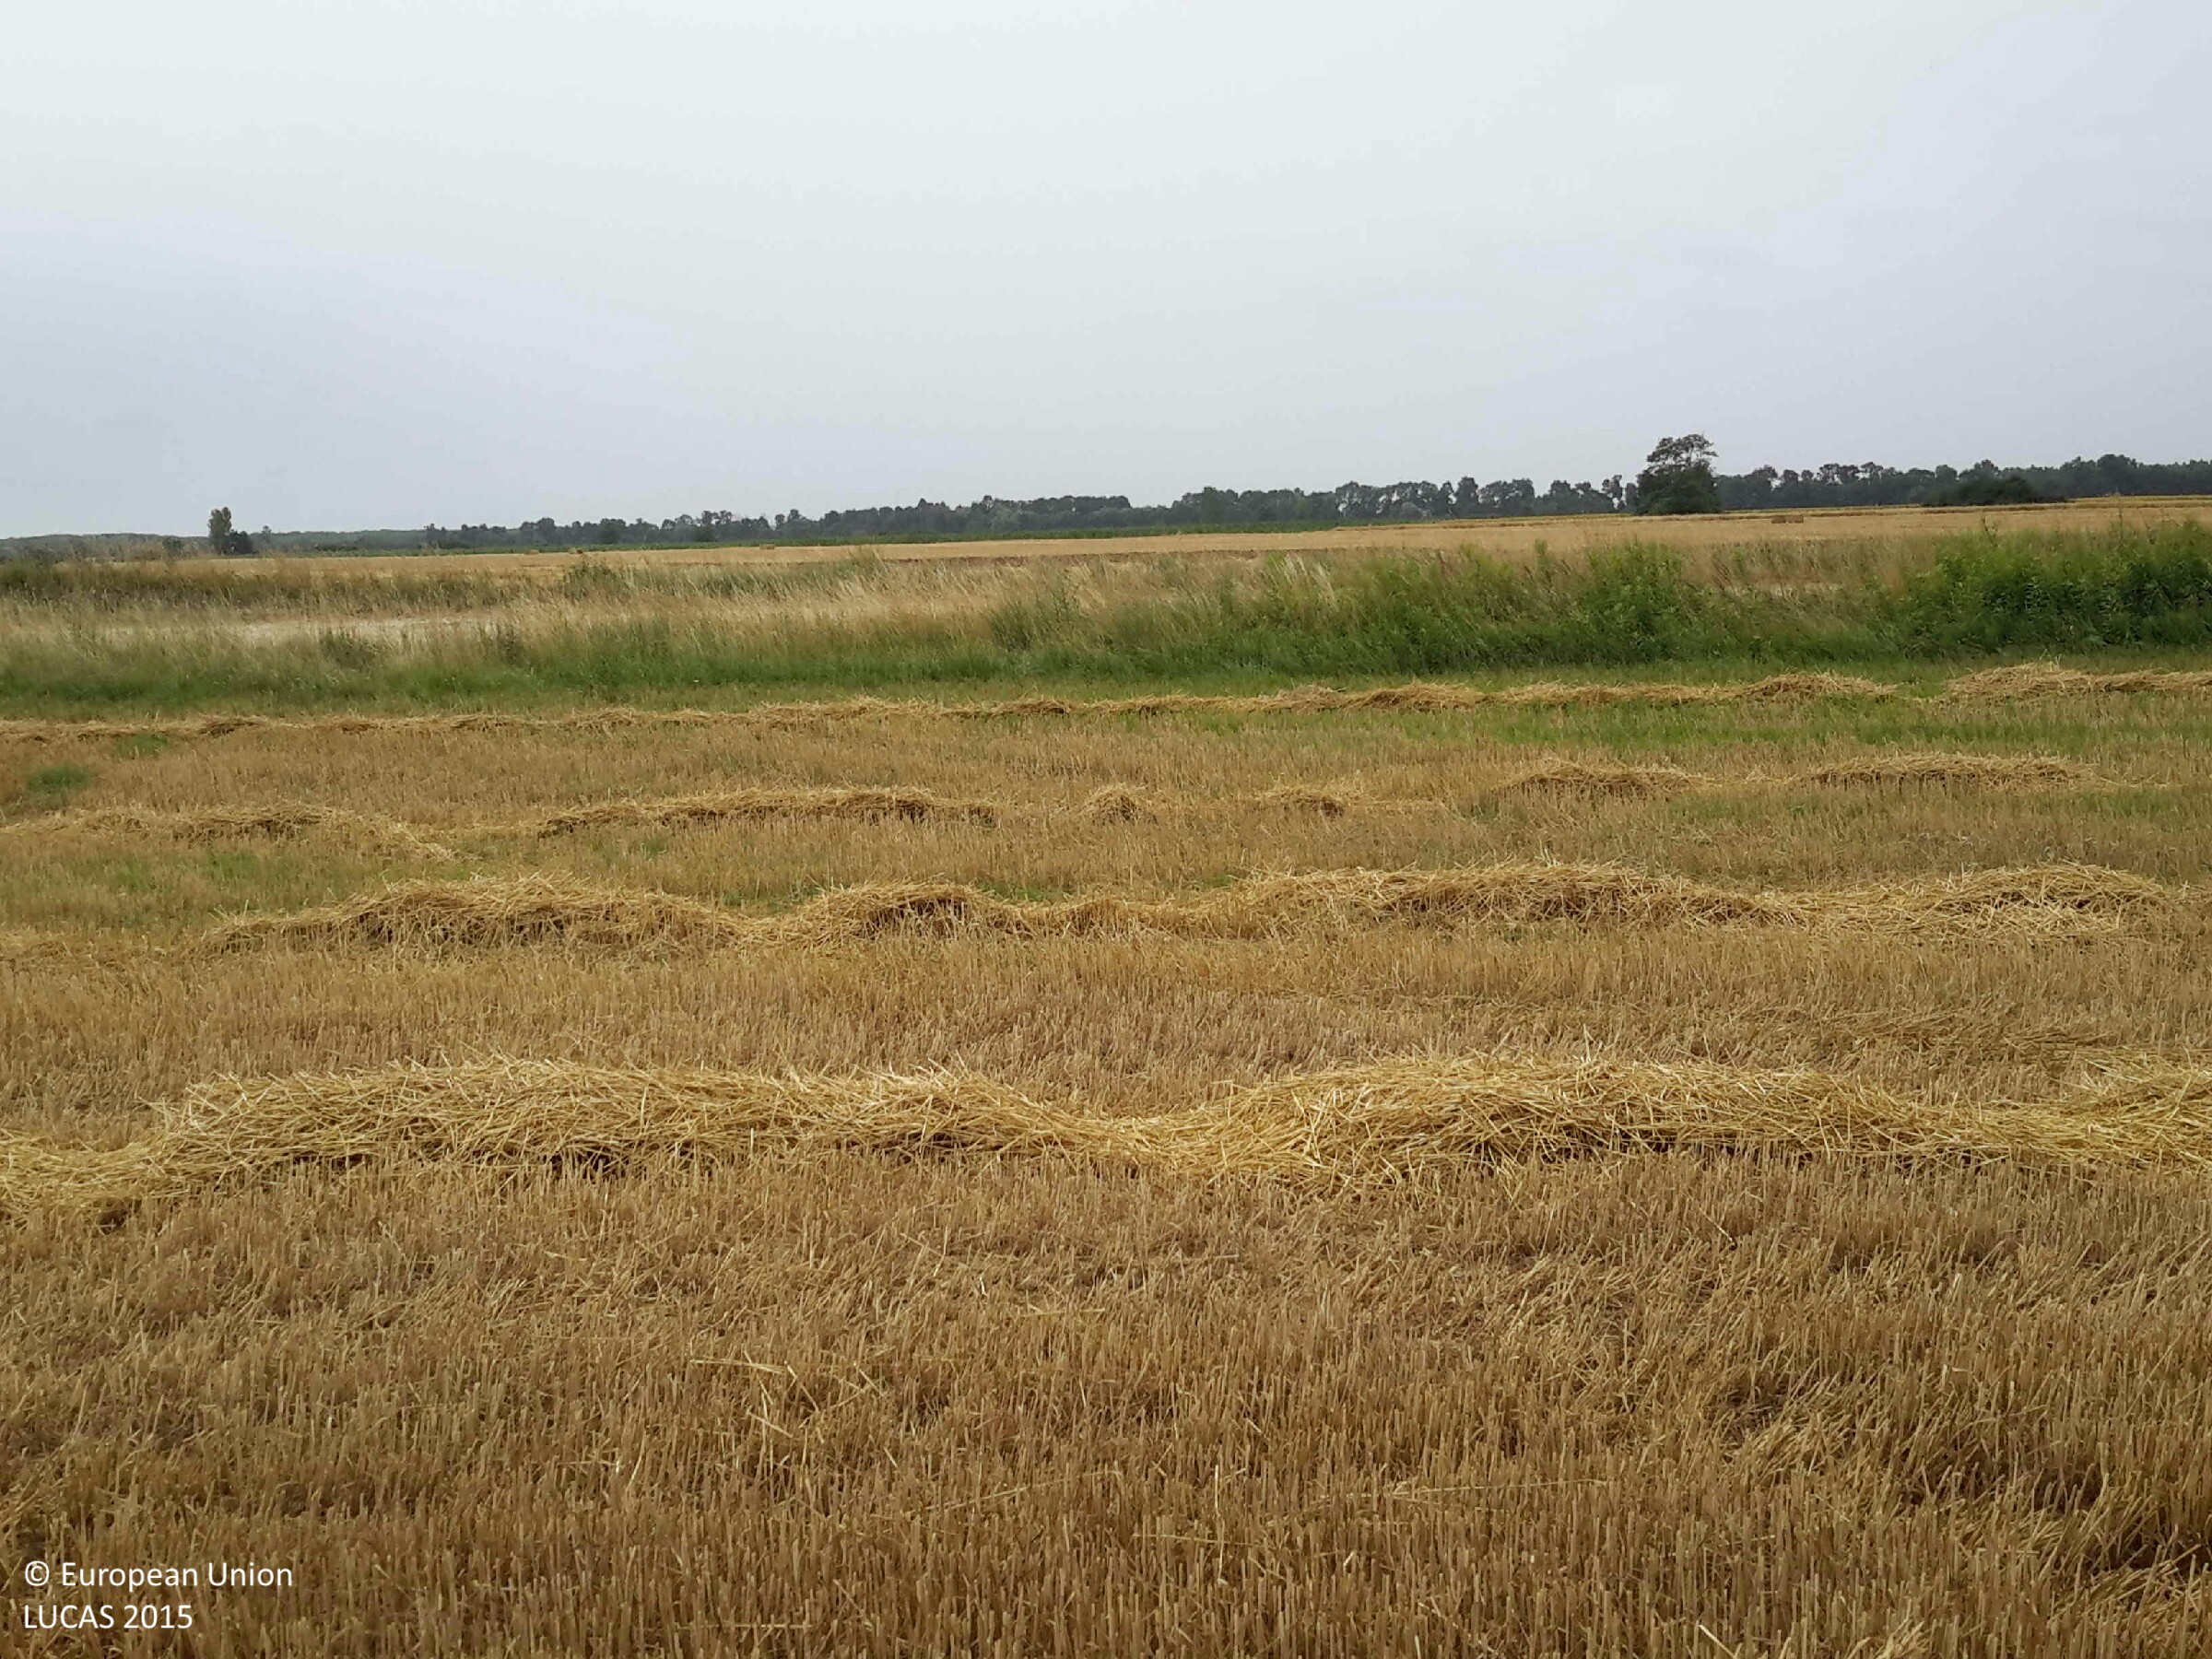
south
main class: Cropland
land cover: Common wheat
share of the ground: 50 - 75 %
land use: Agriculture (excluding fallow land and kitchen gardens)
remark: Harvested field
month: July
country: HU
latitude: 47.3825
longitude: 17.0657
